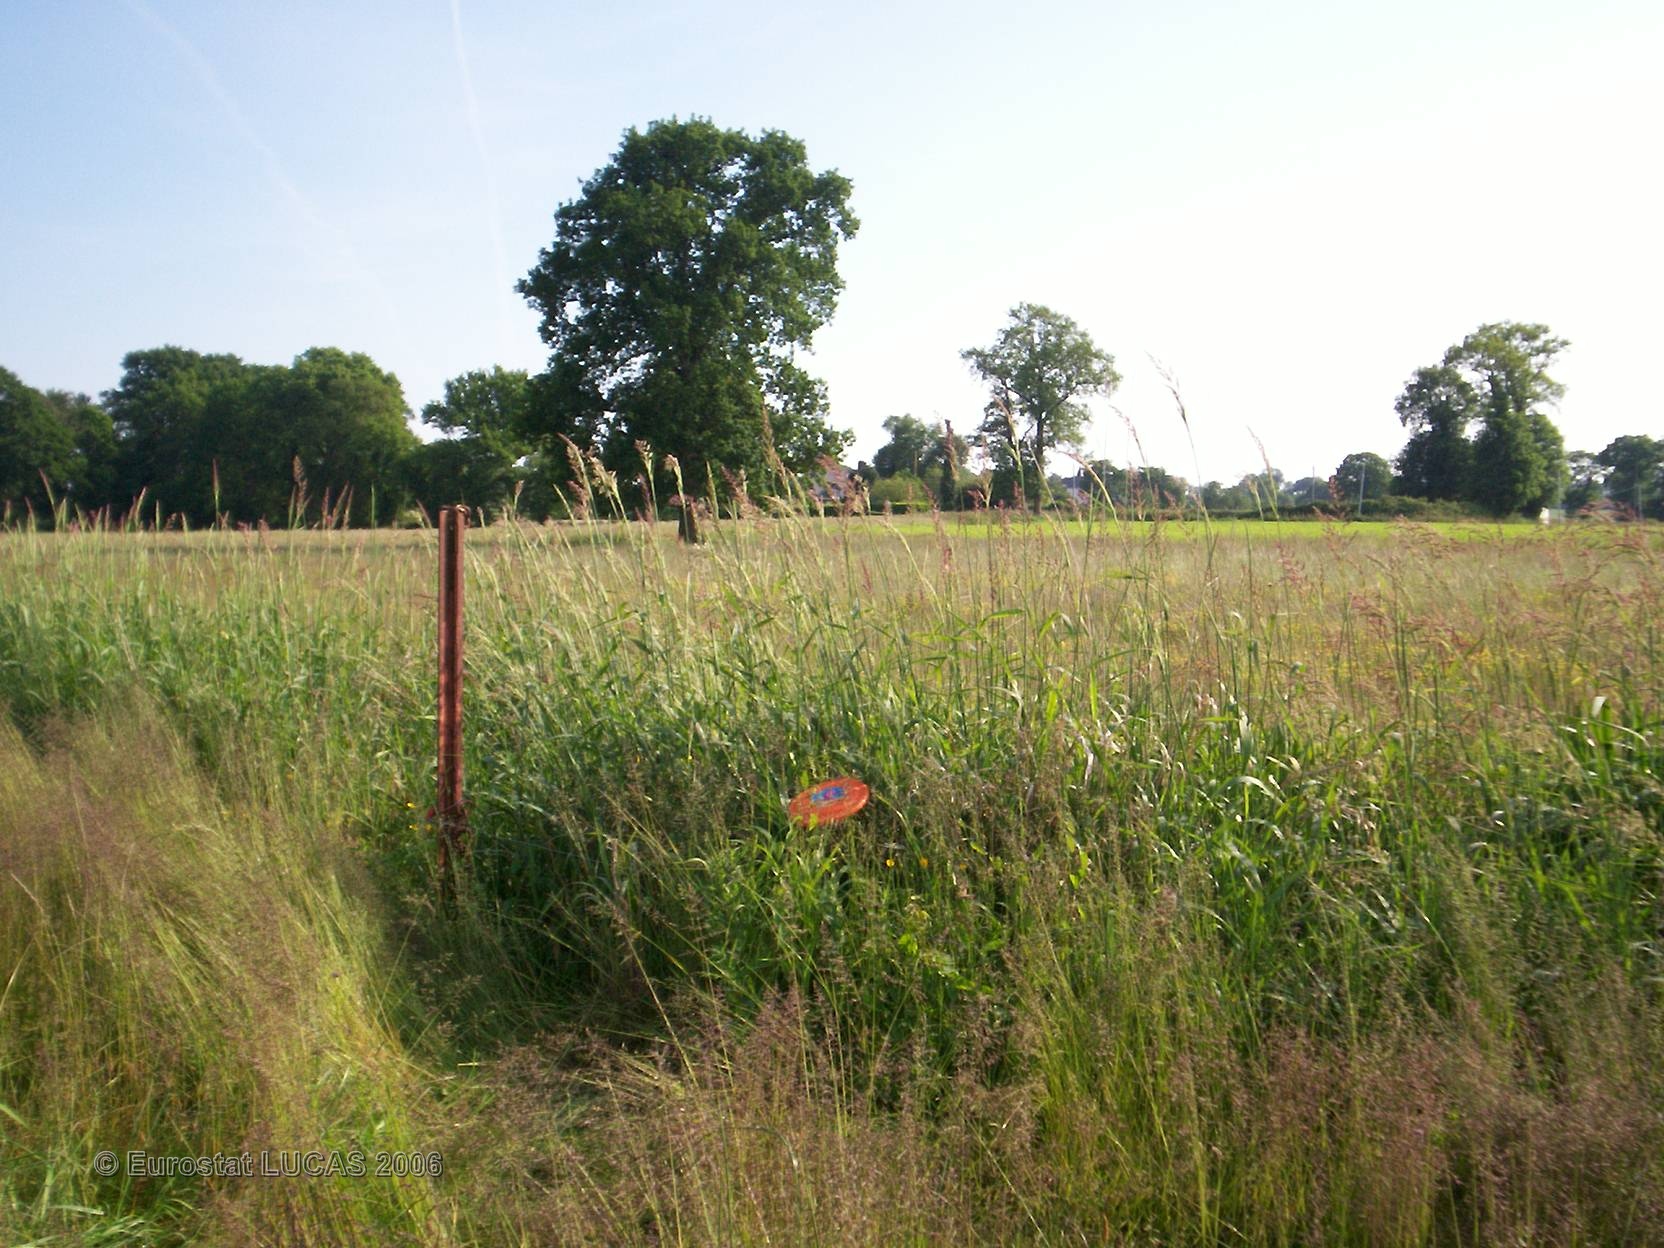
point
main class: Grassland
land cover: Grassland without tree/shrub cover
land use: Agriculture (excluding fallow land and kitchen gardens)
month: June
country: FR
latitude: 48.5421
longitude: -1.7123
